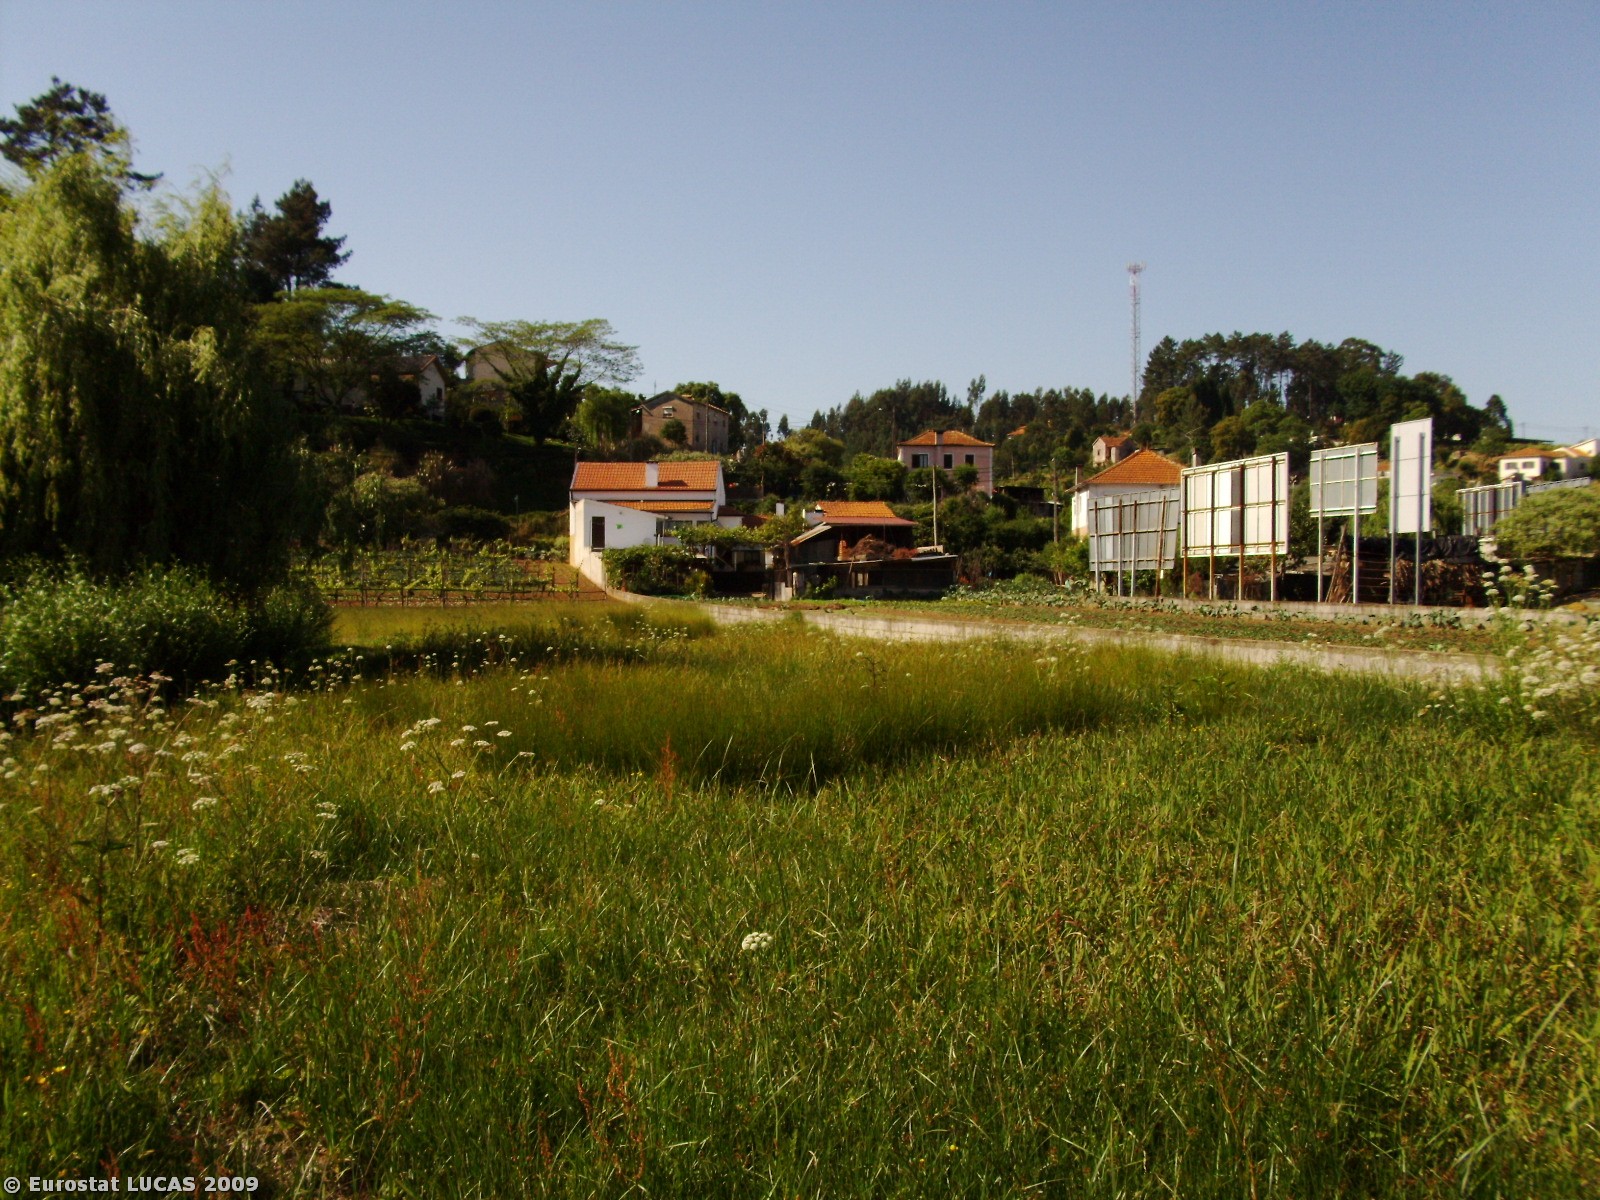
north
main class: Grassland
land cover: Spontaneously vegetated surfaces
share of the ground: > 75 %
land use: Fallow land
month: May
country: PT
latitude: 40.5746
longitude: -8.4355
